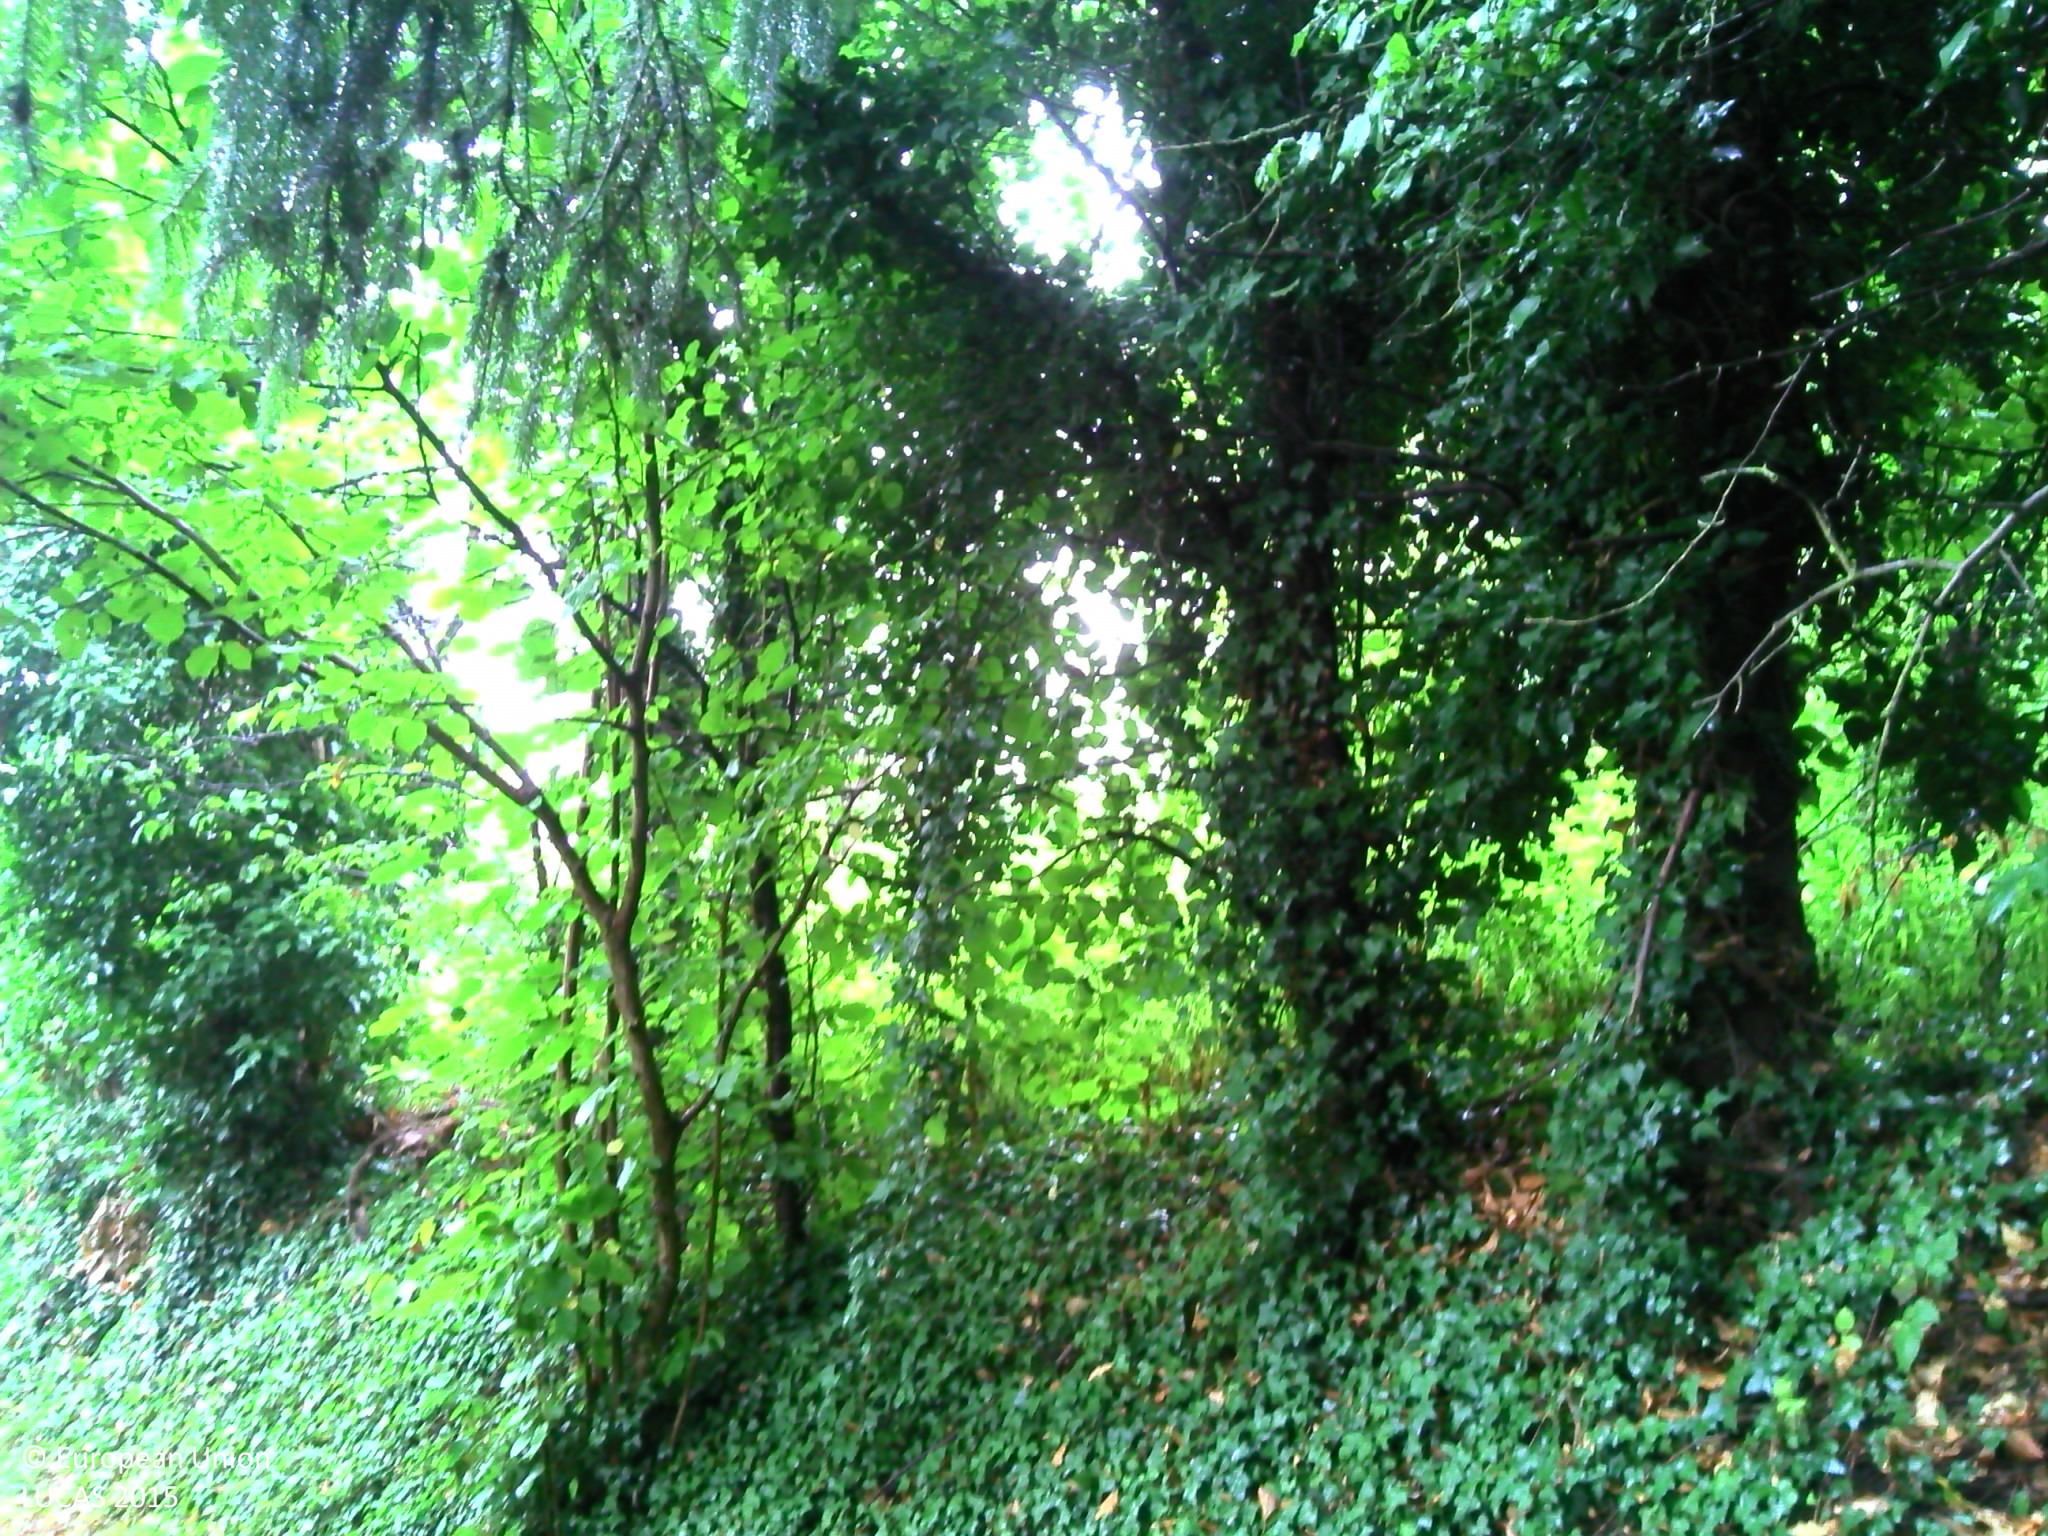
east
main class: Woodland
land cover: Broadleaved woodland
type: mesophytic deciduous forest
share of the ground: > 75 %
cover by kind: broadleaved forest trees 80 %, coniferous forest trees 15 %, herbaceous plants 5 %
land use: Forestry
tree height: > 5 m
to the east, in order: Broadleaved woodland; Fences; Tracks; Broadleaved woodland; Tracks; Broadleaved woodland; Tracks; Broadleaved woodland
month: August
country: FR
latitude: 47.7428
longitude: 7.4008
